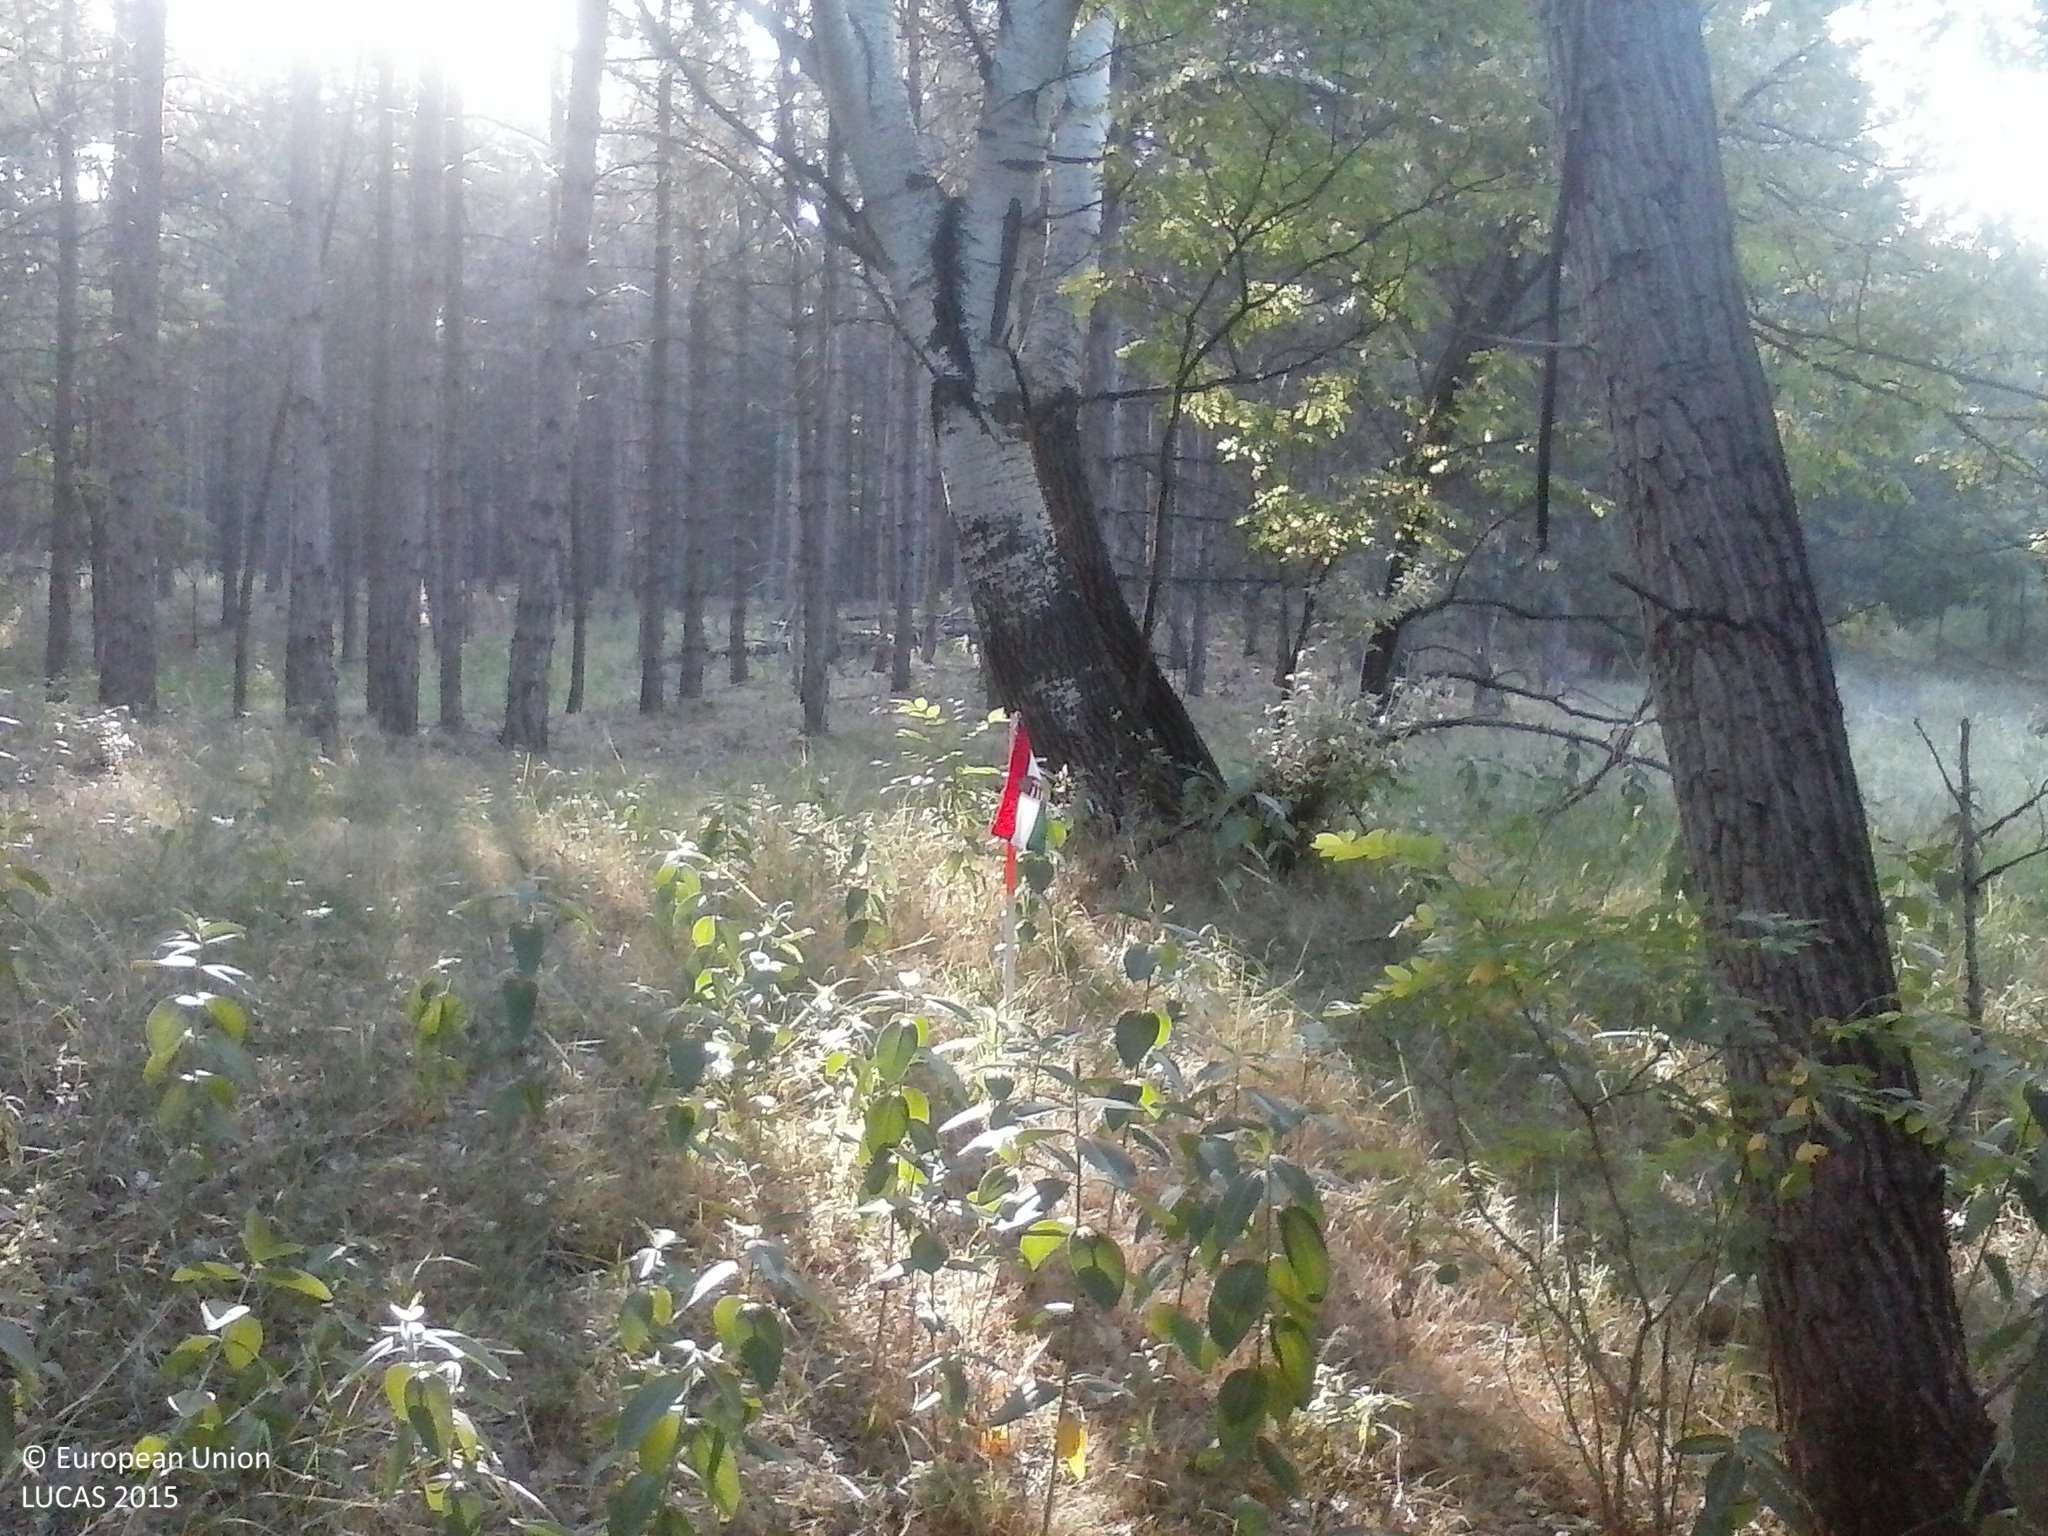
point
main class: Woodland
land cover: Pine dominated coniferous woodland
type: hemiboreal forest and nemoral coniferous forest and mixed broadleaved-coniferous forest
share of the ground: > 75 %
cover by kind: coniferous forest trees 80 %, broadleaved forest trees 10 %, shrubs 5 %, herbaceous plants 5 %
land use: Forestry
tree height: > 5 m
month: July
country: HU
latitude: 46.4053
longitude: 19.6308
